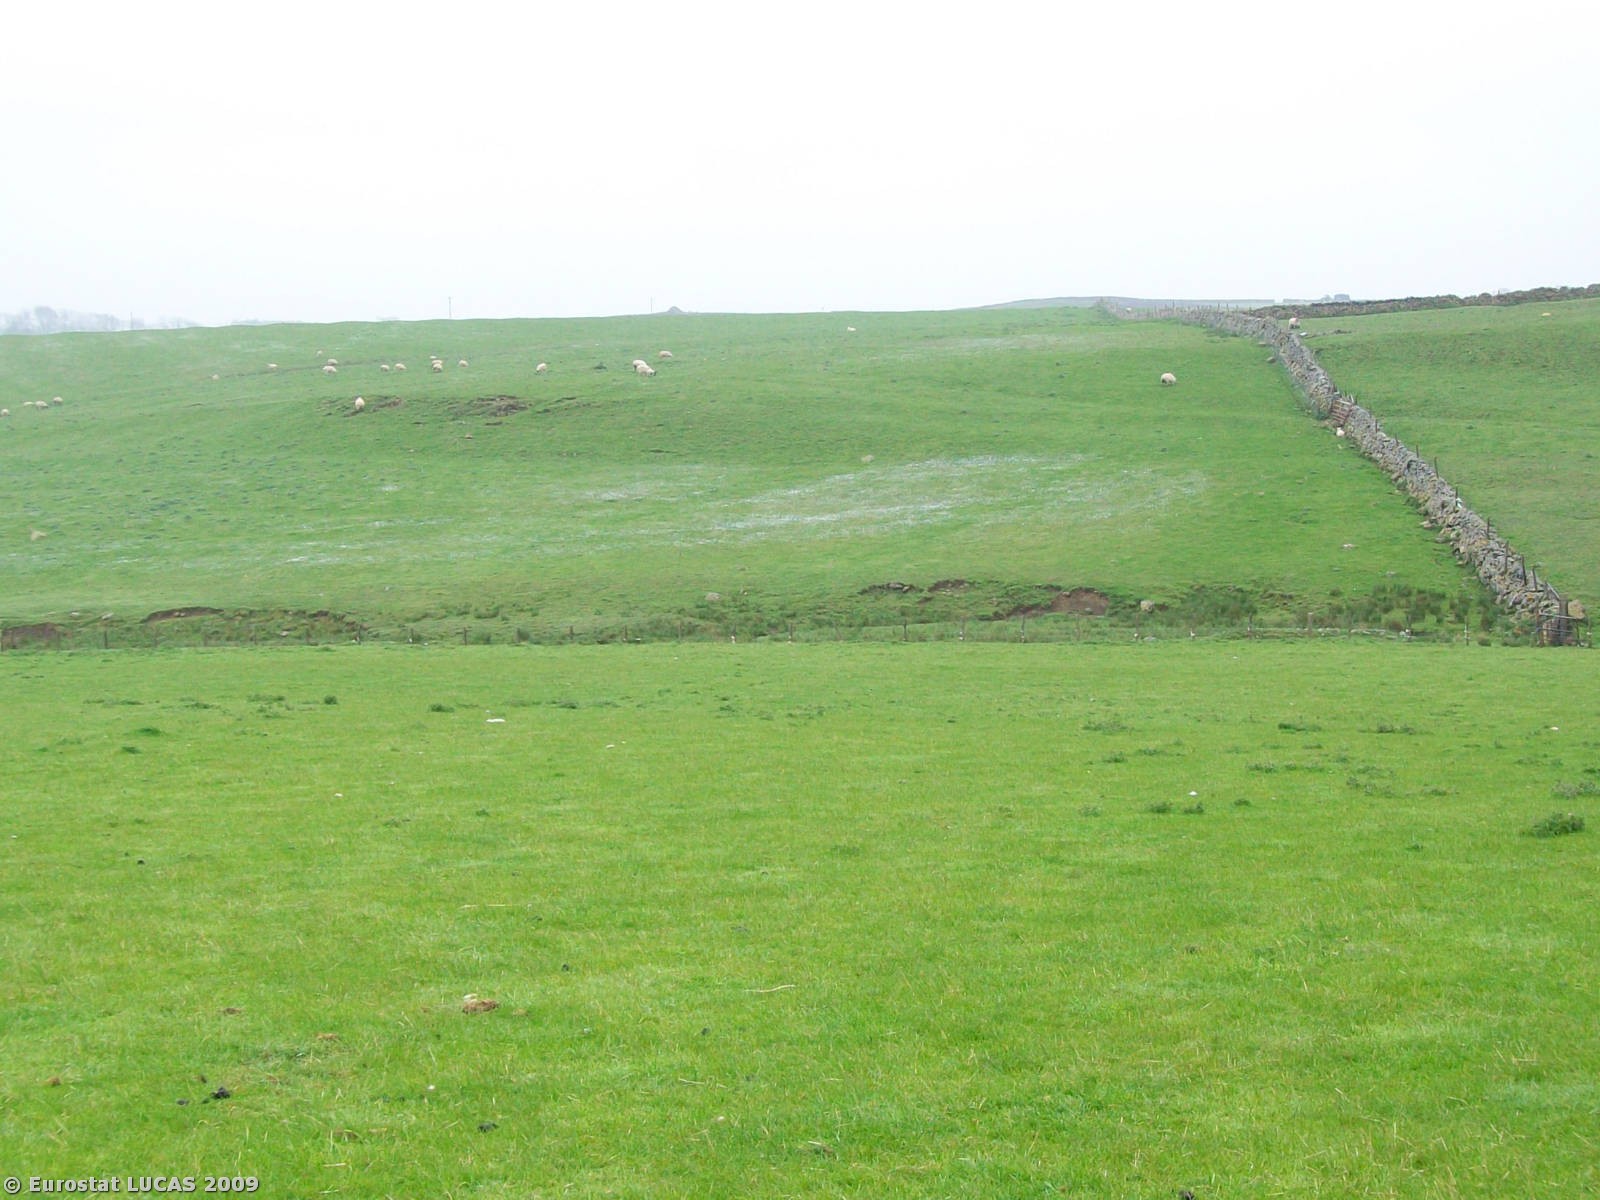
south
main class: Grassland
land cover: Grassland without tree/shrub cover
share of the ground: > 75 %
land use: Agriculture (excluding fallow land and kitchen gardens)
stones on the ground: < 10 %
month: May
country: GB
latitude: 55.1289
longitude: -2.0209
